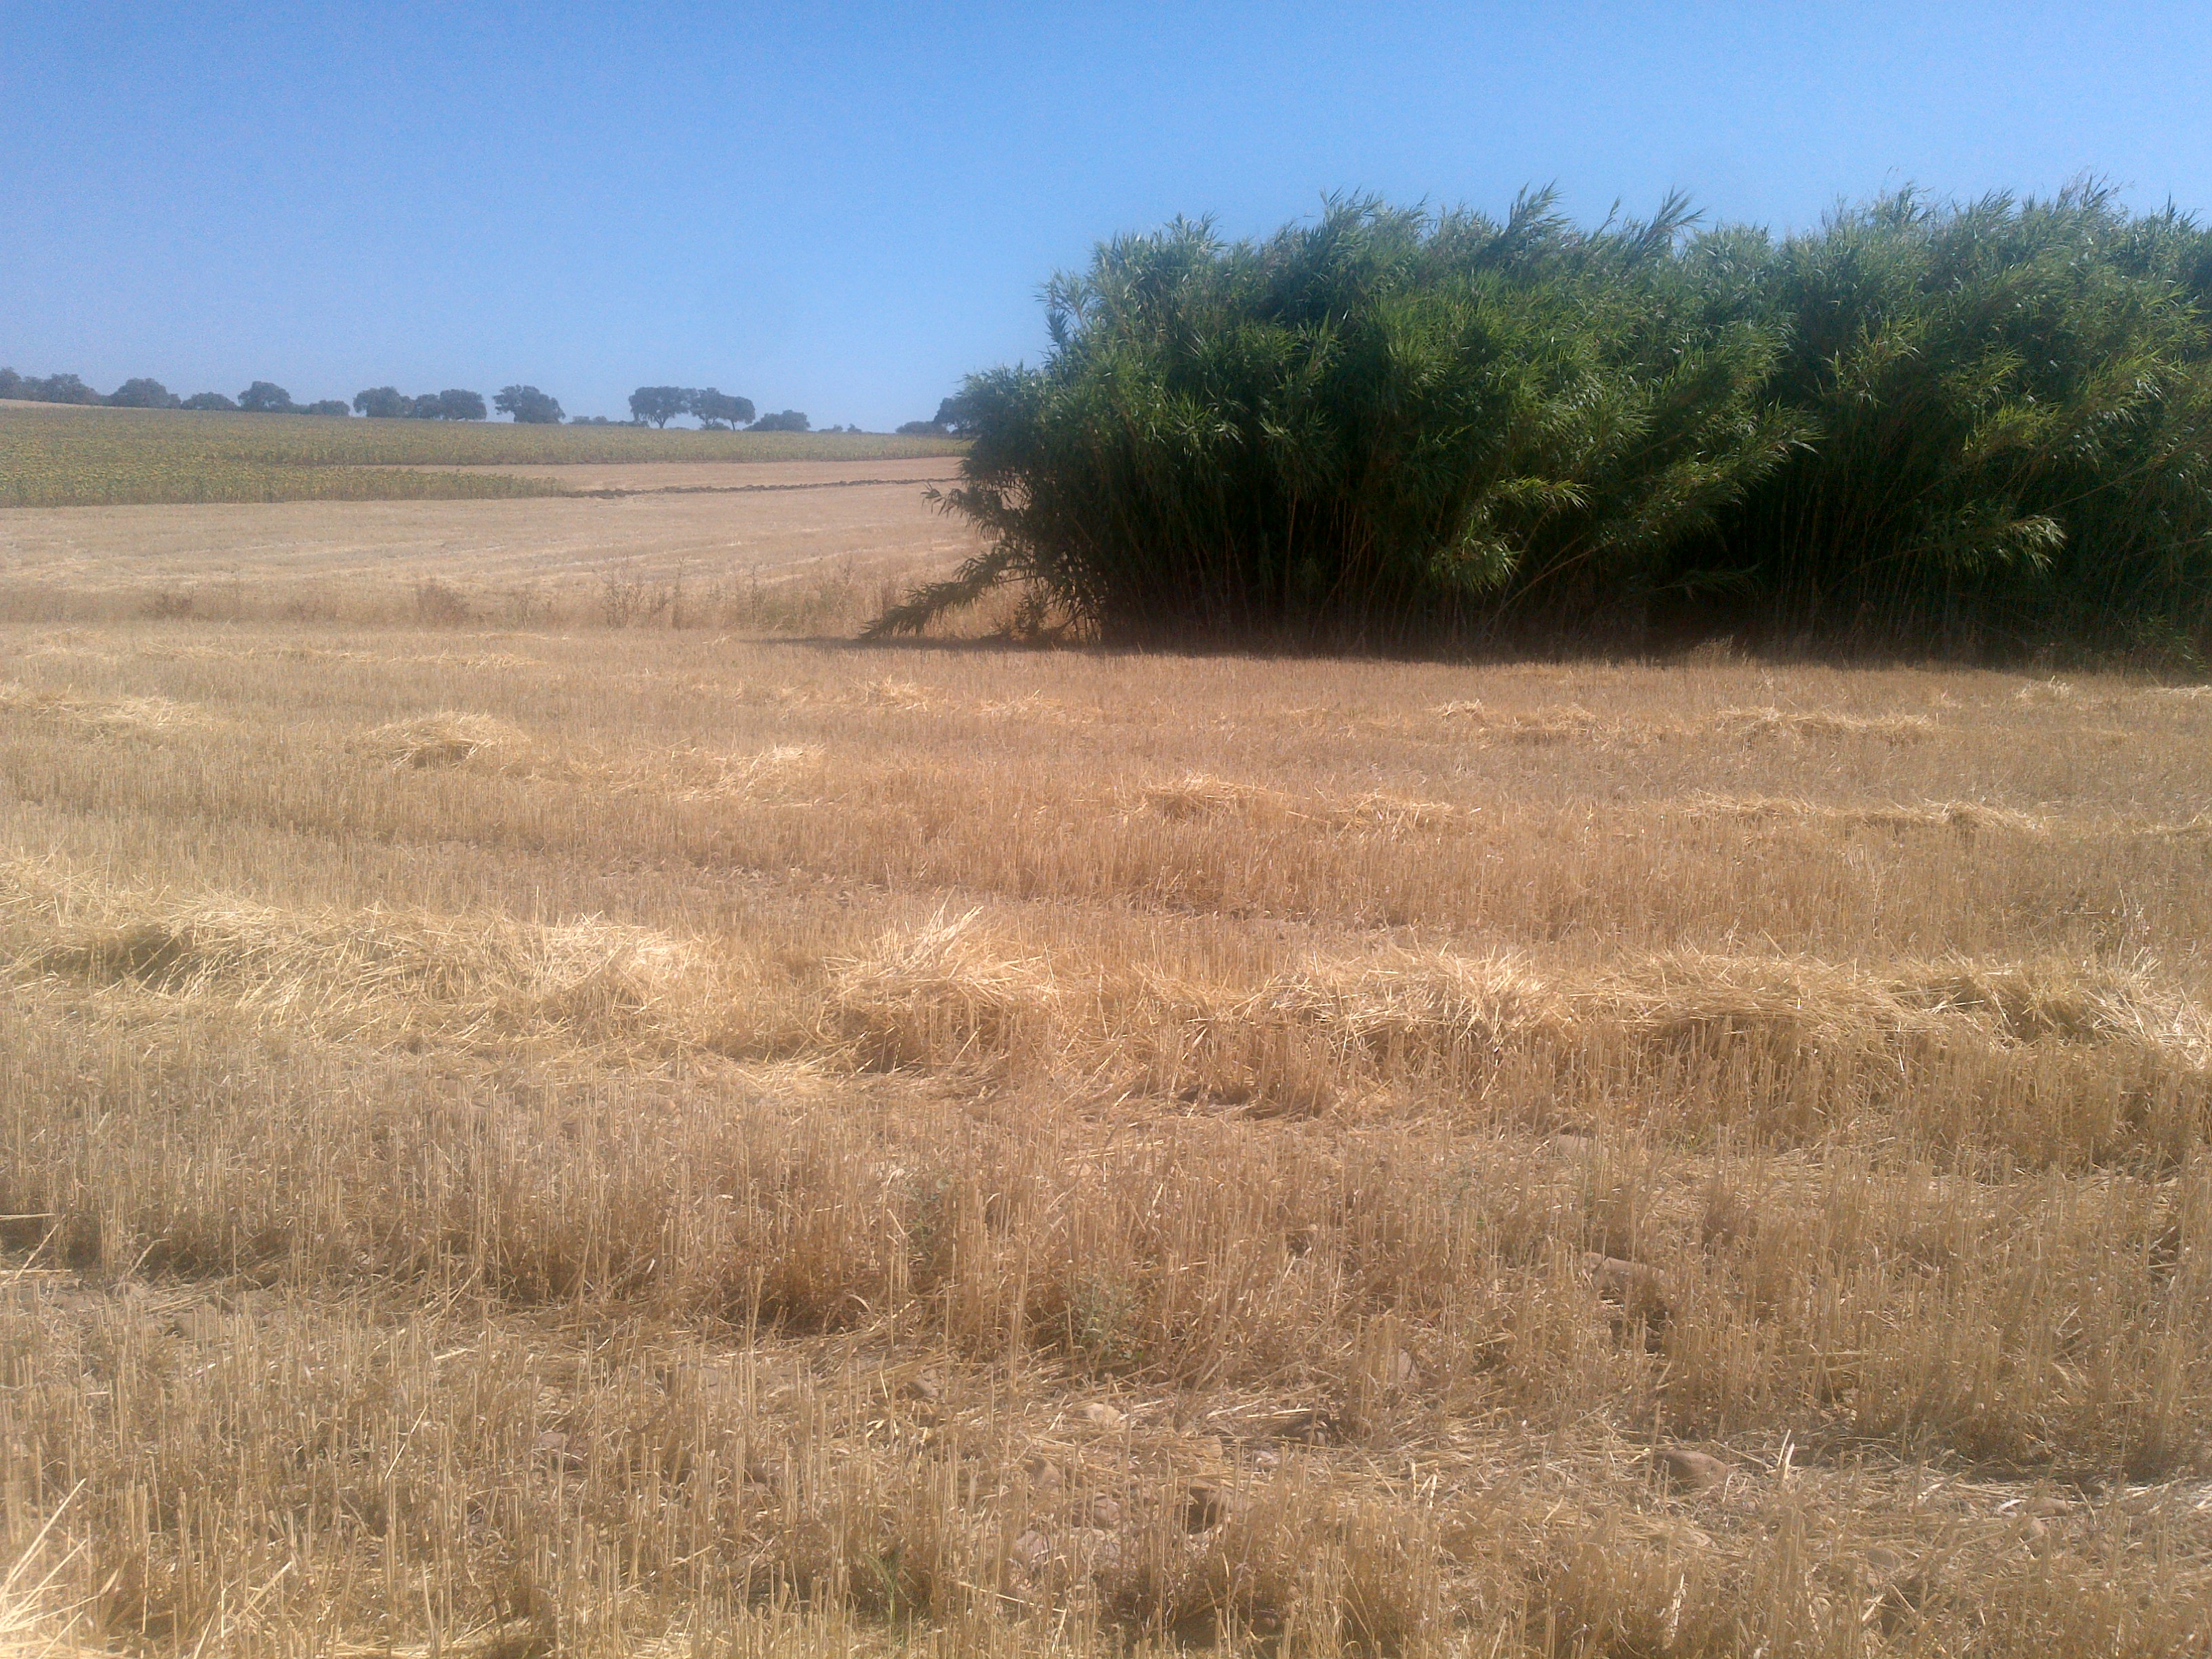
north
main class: Cropland
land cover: Durum wheat
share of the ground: < 10 %
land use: Agriculture (excluding fallow land and kitchen gardens)
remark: Harvested field
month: June
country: ES
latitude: 37.7028
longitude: -4.9284
